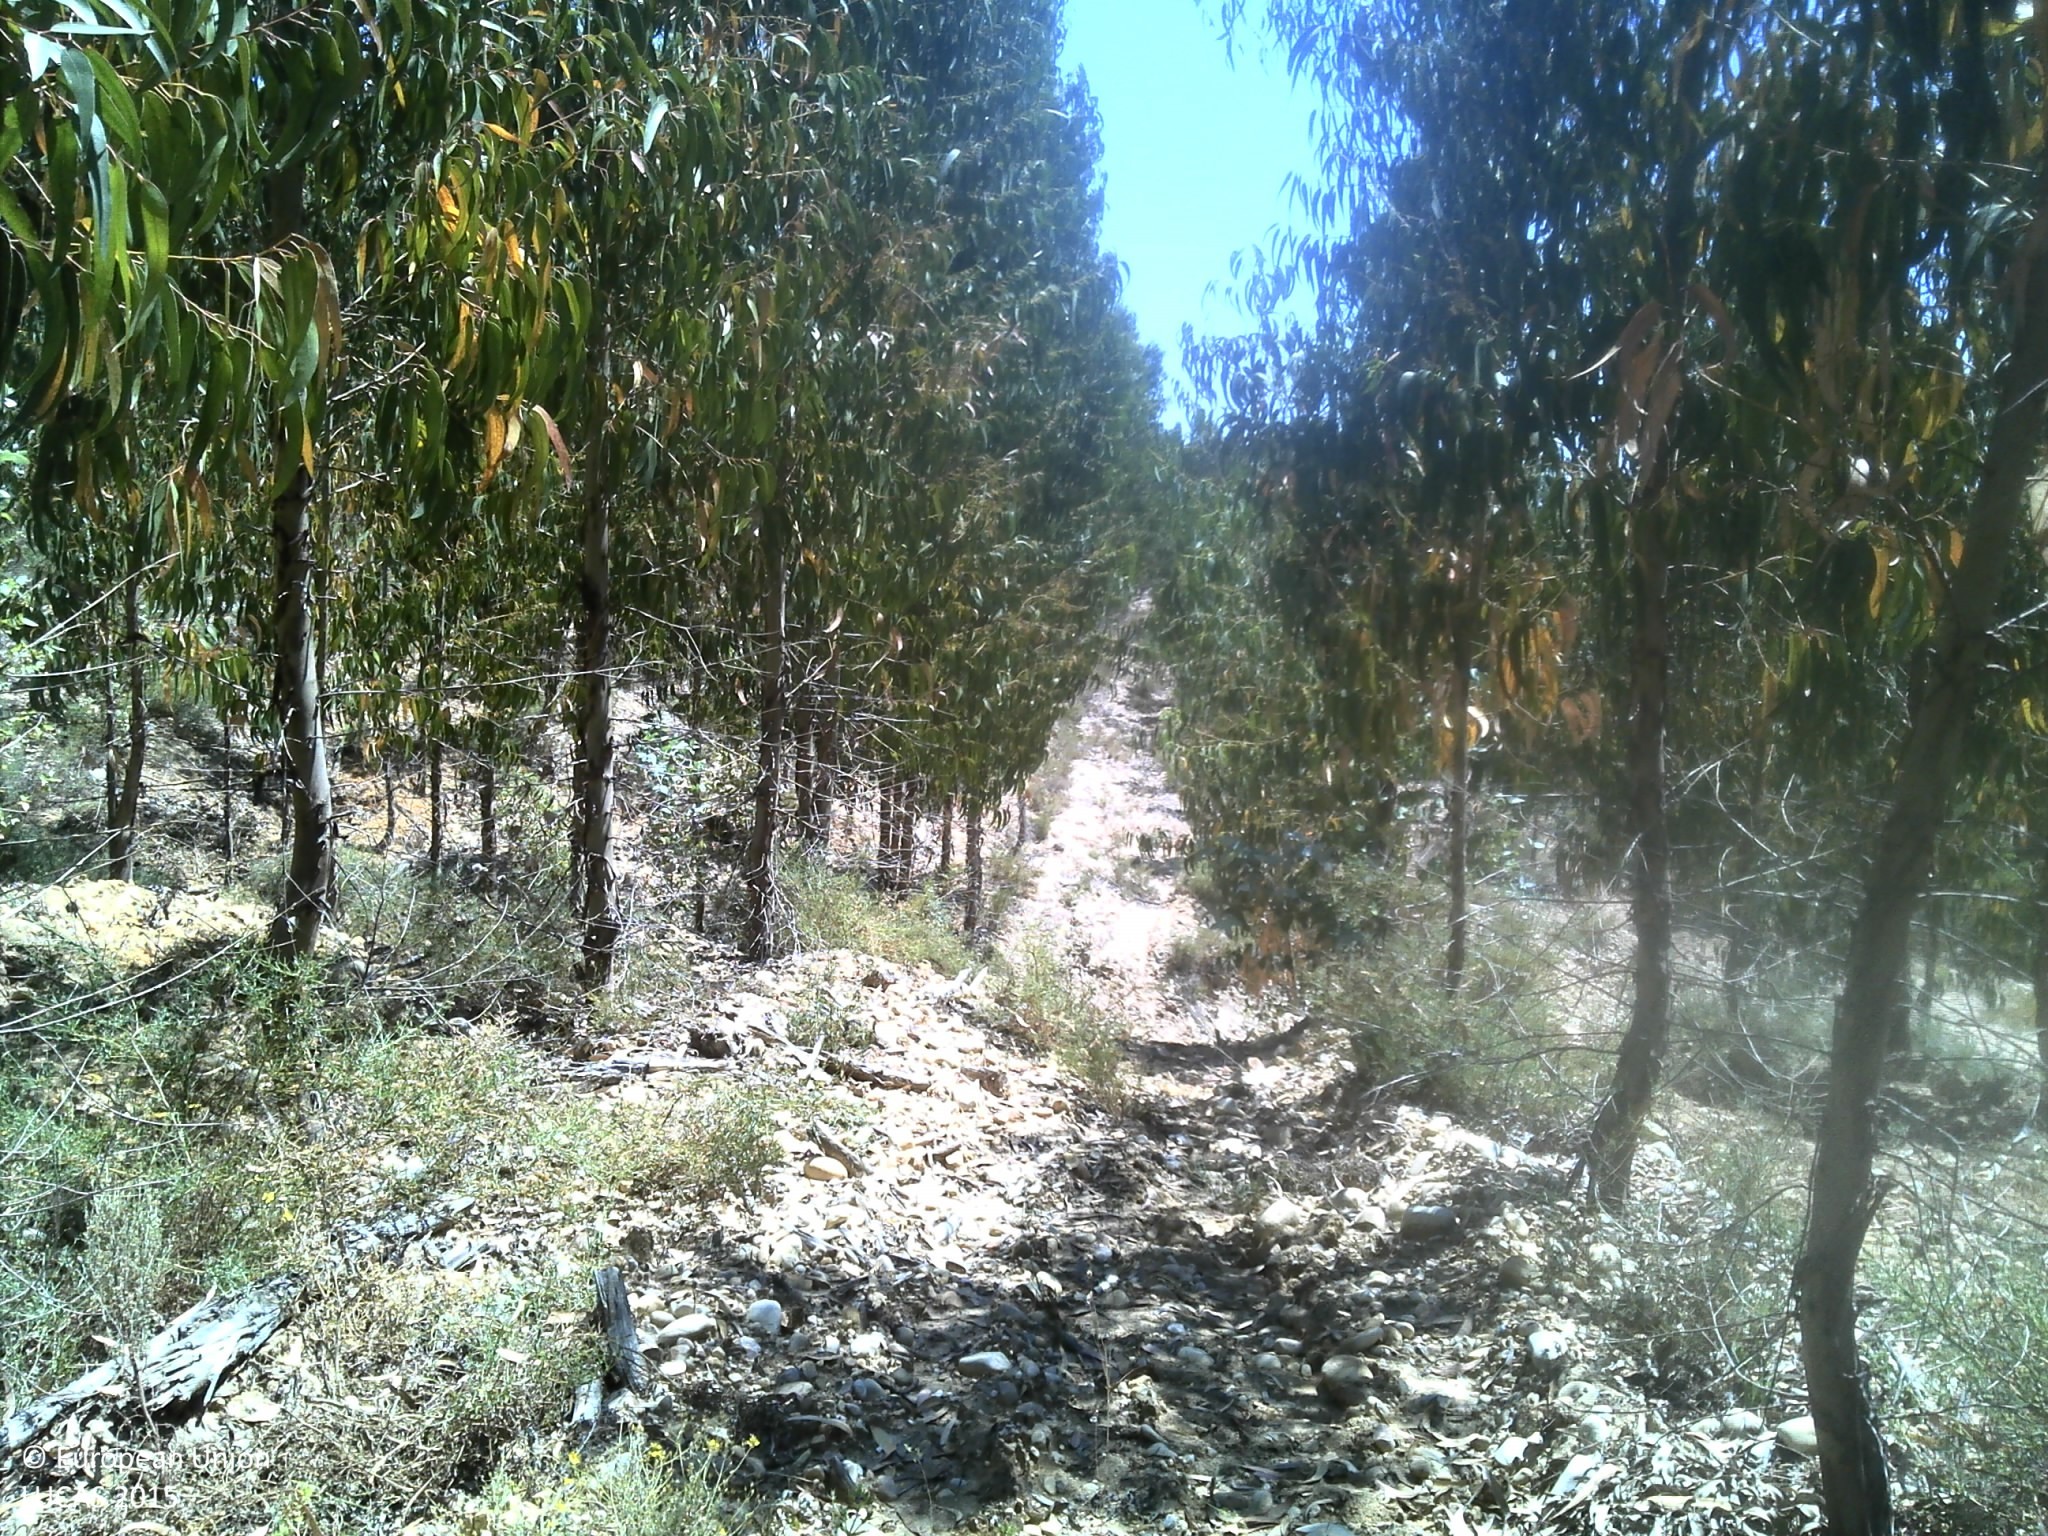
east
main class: Woodland
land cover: Broadleaved woodland
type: exotic forest
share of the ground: 25 - 50 %
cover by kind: broadleaved forest trees 60 %, shrubs 20 %, herbaceous plants 20 %
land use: Forestry
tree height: > 5 m
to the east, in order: Broadleaved woodland; Tracks; Shrubland with sparse tree cover; Tracks; Broadleaved woodland; Tracks; Broadleaved woodland
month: May
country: PT
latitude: 39.3622
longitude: -8.2976
